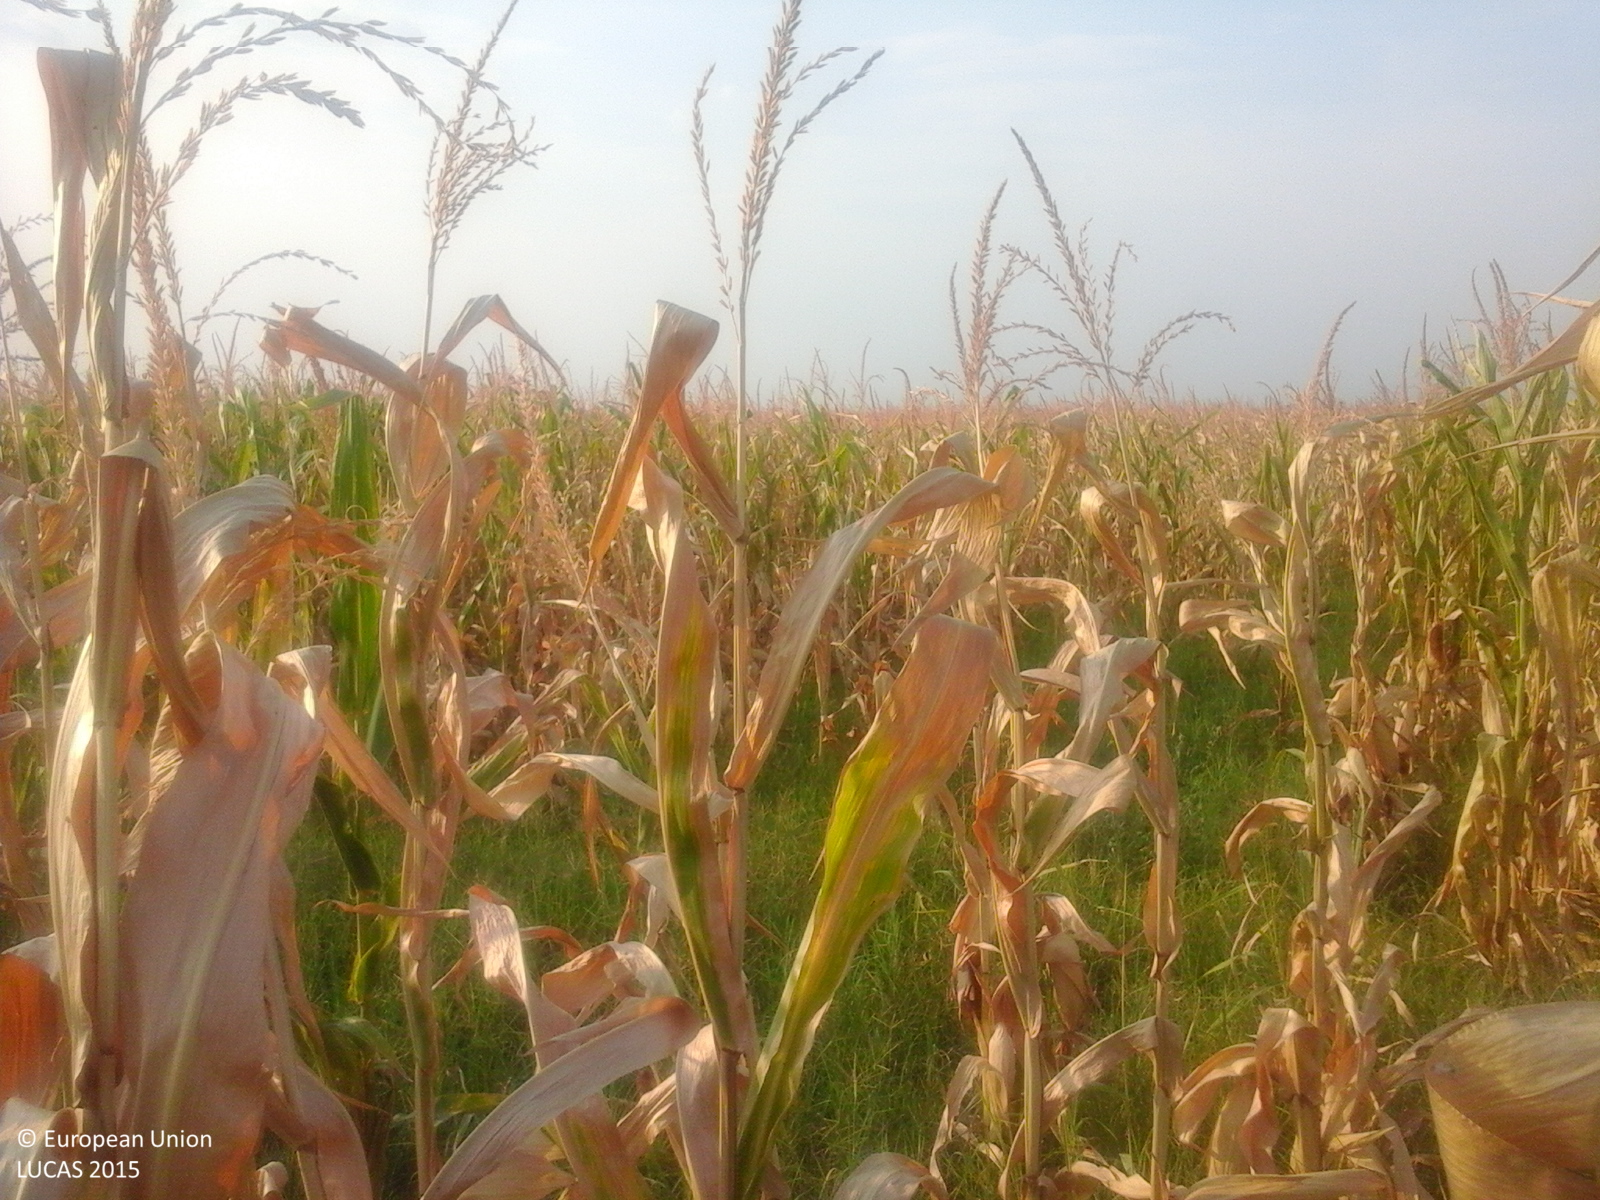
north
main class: Cropland
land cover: Maize
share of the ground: > 75 %
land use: Agriculture (excluding fallow land and kitchen gardens)
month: August
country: RO
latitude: 44.1223
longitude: 22.9253
